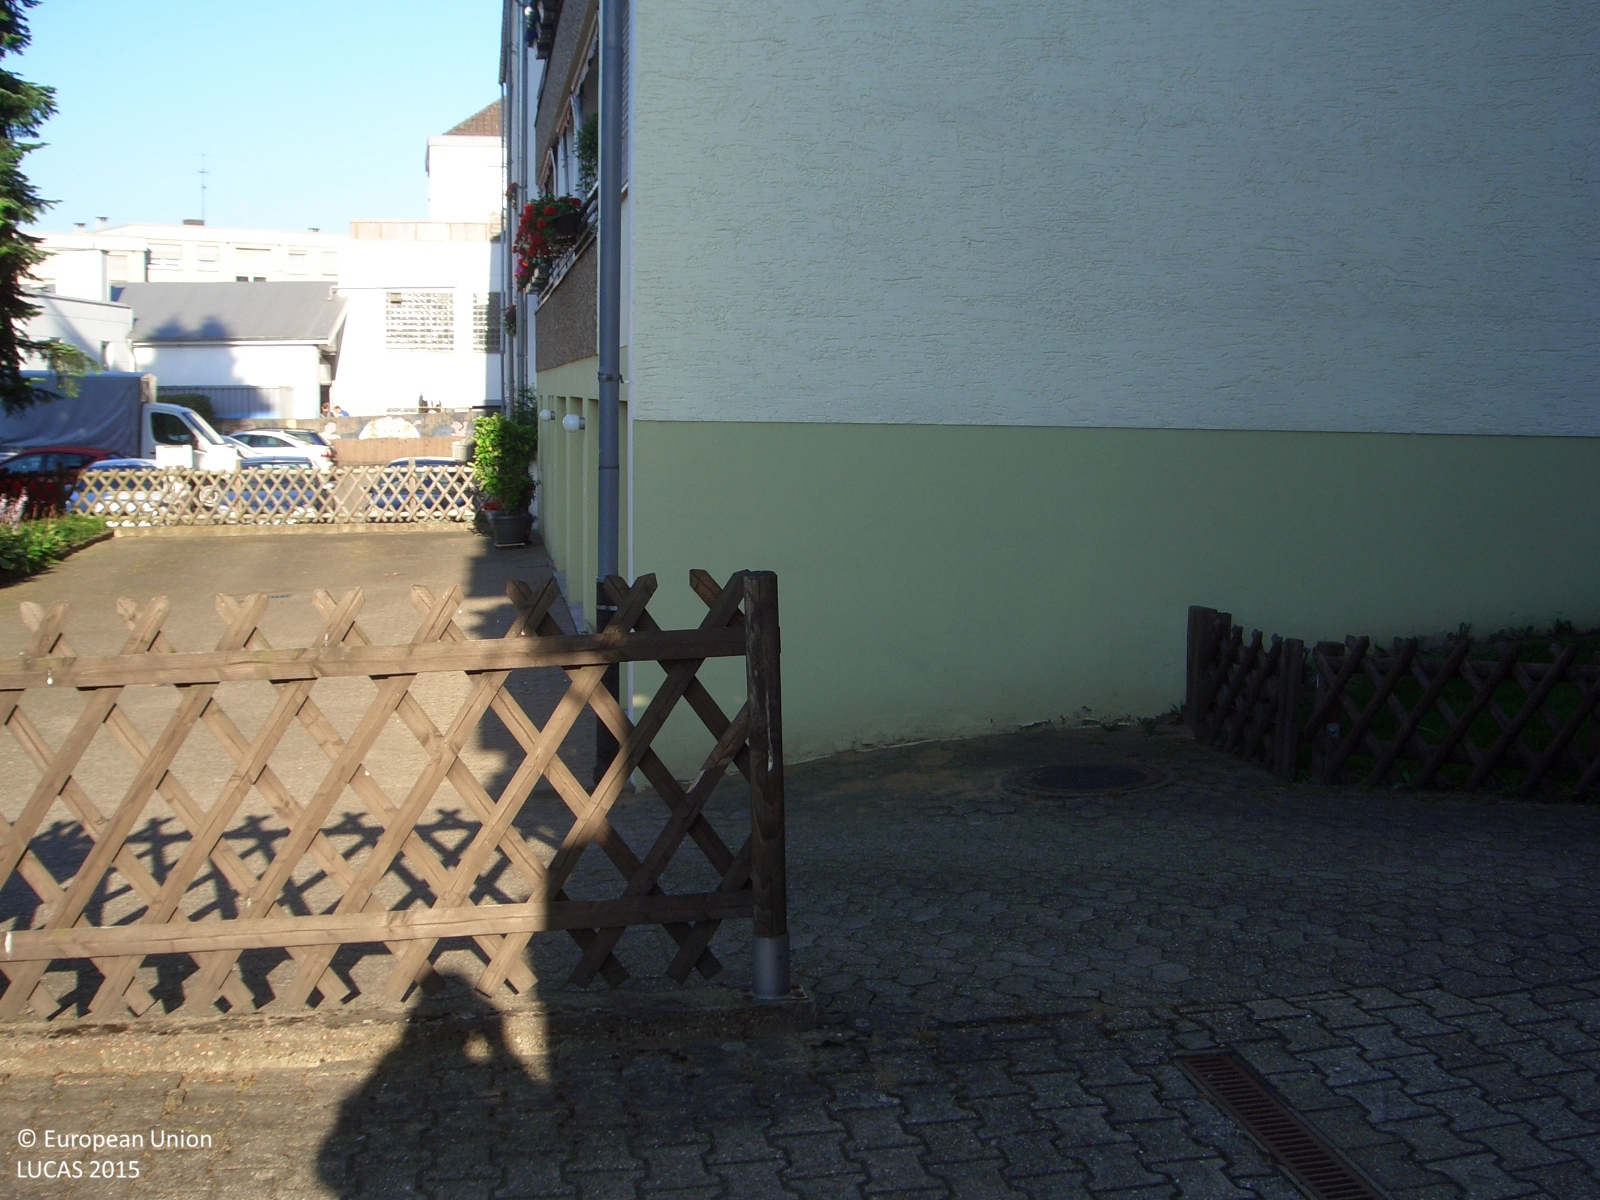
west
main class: Grassland
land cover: Grassland with sparse tree/shrub cover
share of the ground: > 75 %
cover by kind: herbaceous plants 95 %, broadleaved forest trees 5 %
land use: Residential
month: June
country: DE
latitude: 51.0636
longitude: 7.0463
